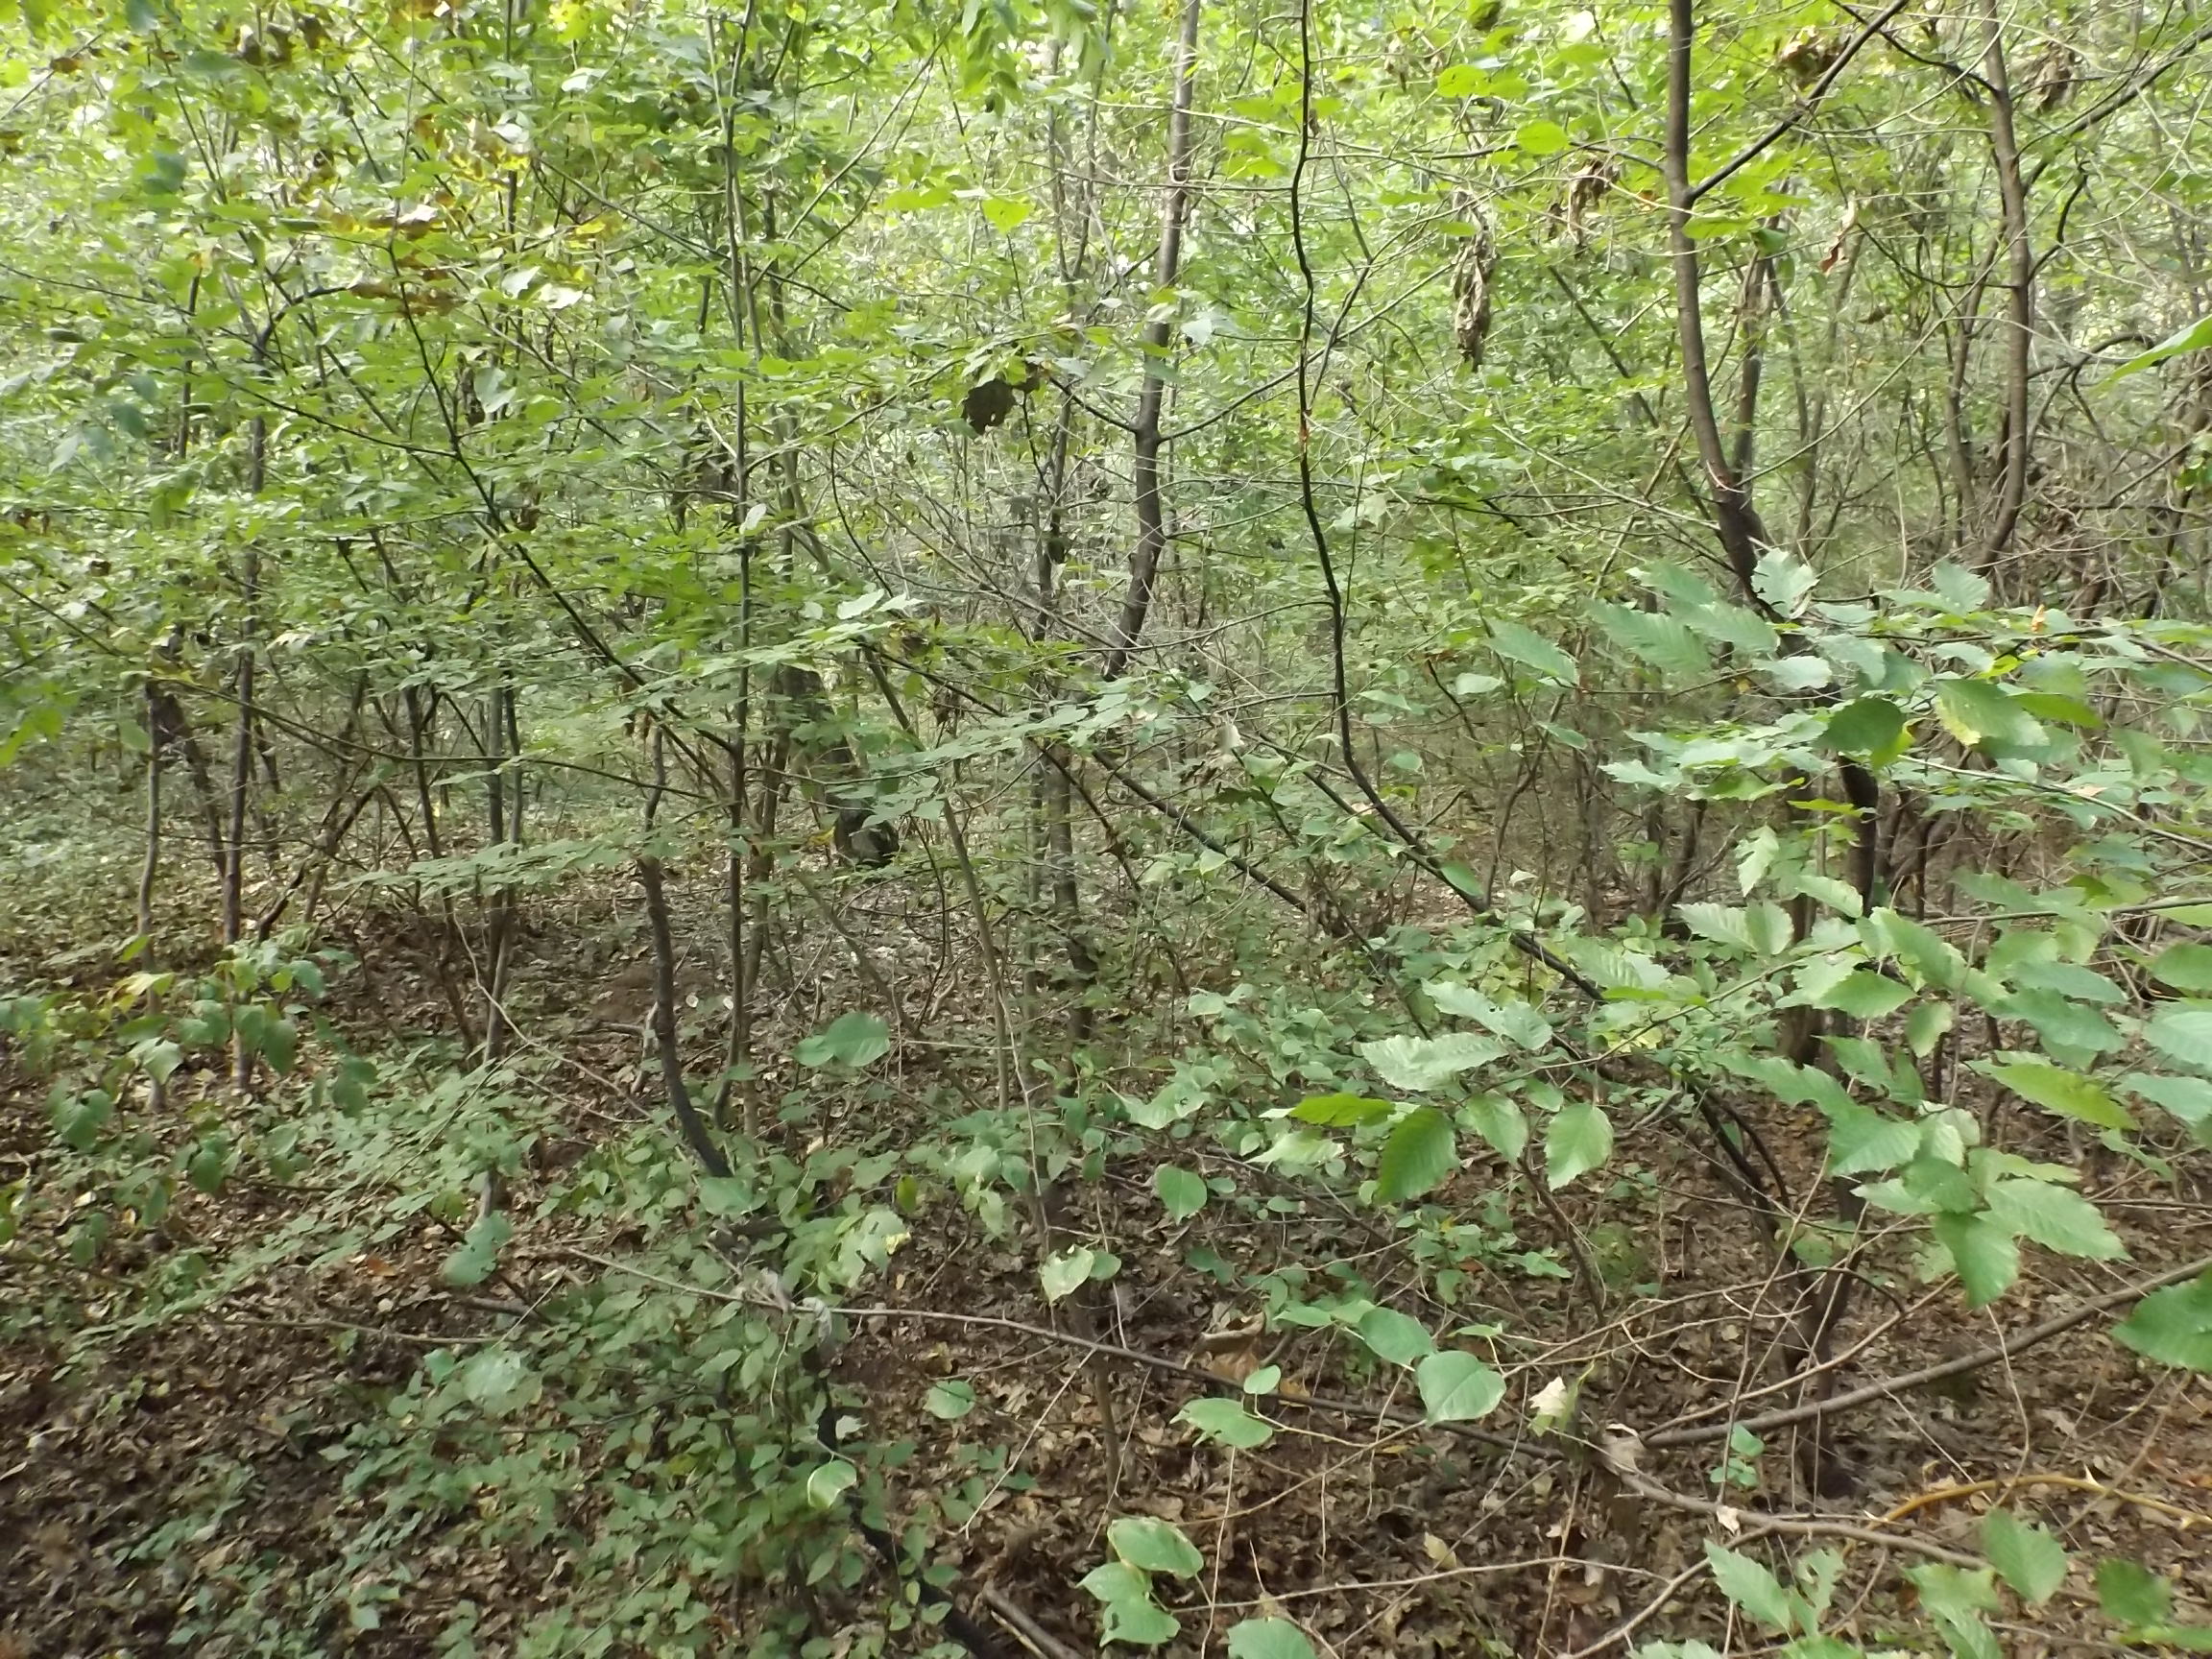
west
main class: Woodland
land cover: Broadleaved woodland
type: beech forest
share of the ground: > 75 %
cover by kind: broadleaved forest trees 100 %
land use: Forestry
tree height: > 5 m
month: October
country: BG
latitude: 43.8655
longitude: 26.8279
